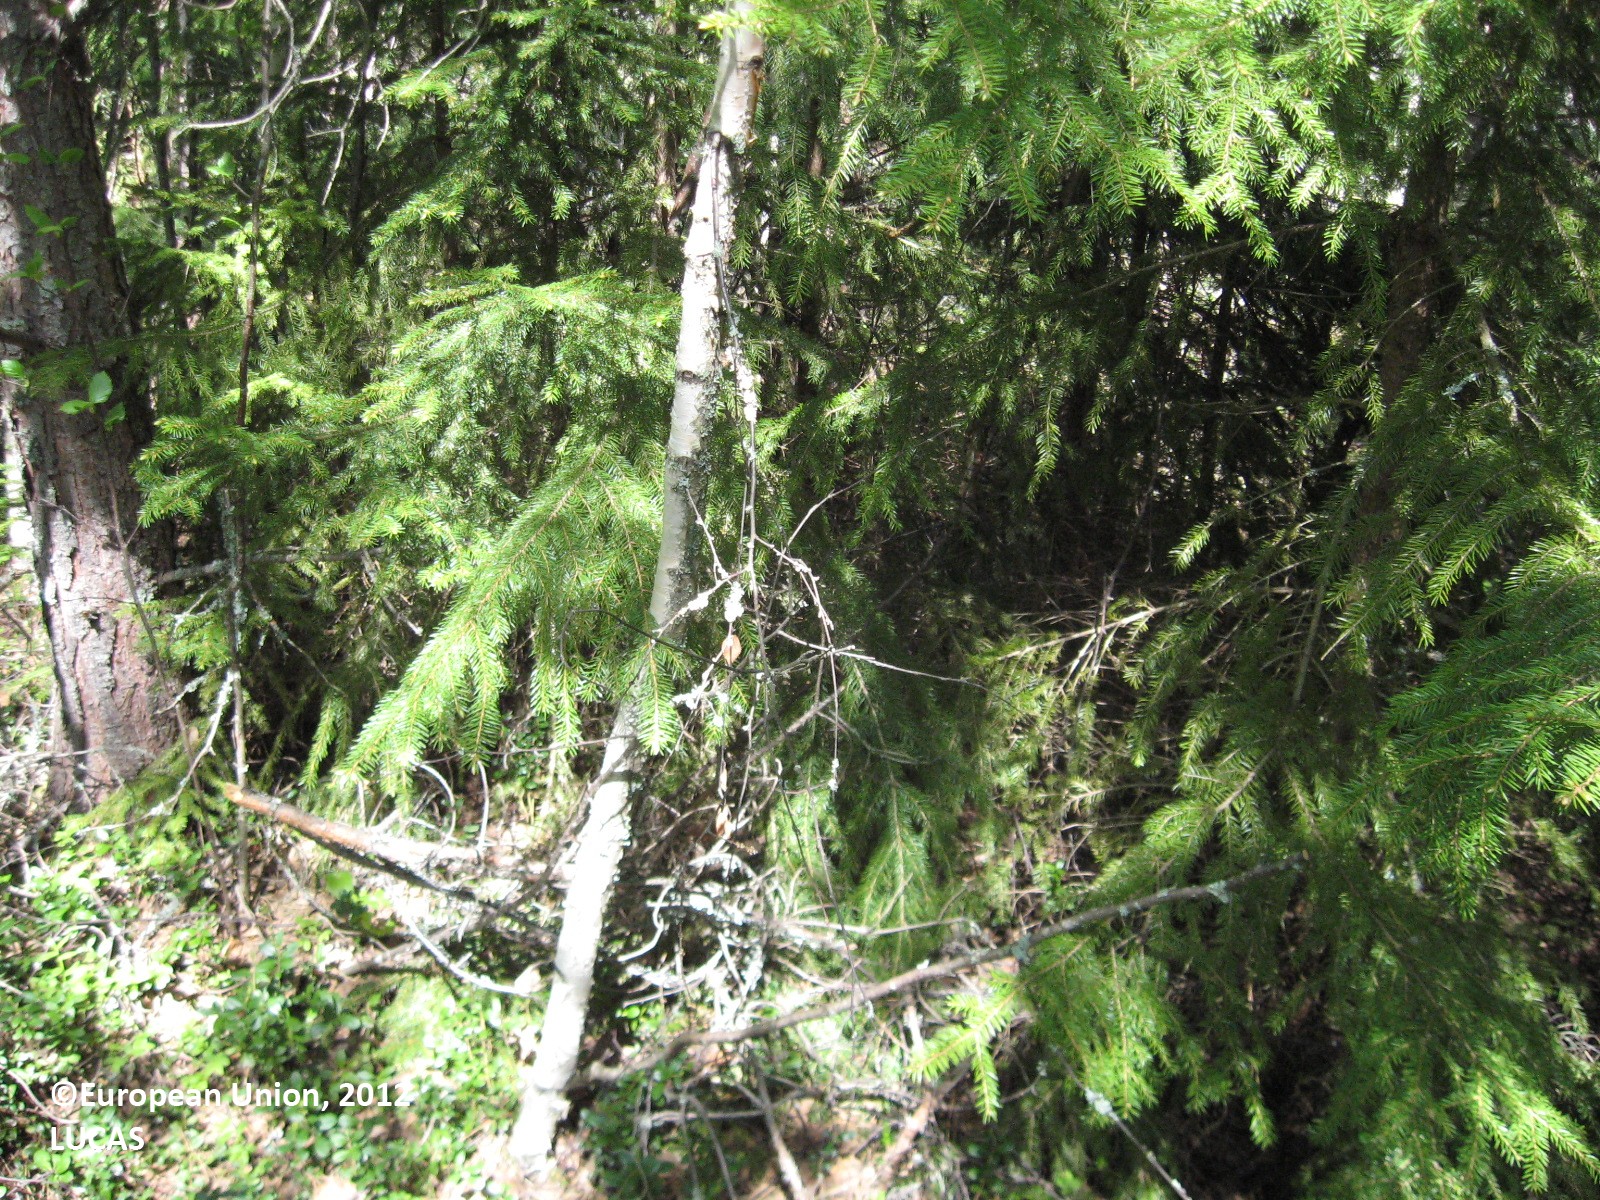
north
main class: Woodland
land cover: Pine dominated mixed woodland
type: boreal forest
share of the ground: > 75 %
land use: Forestry
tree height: > 5 m
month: June
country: FI
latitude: 63.2042
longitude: 21.3496
